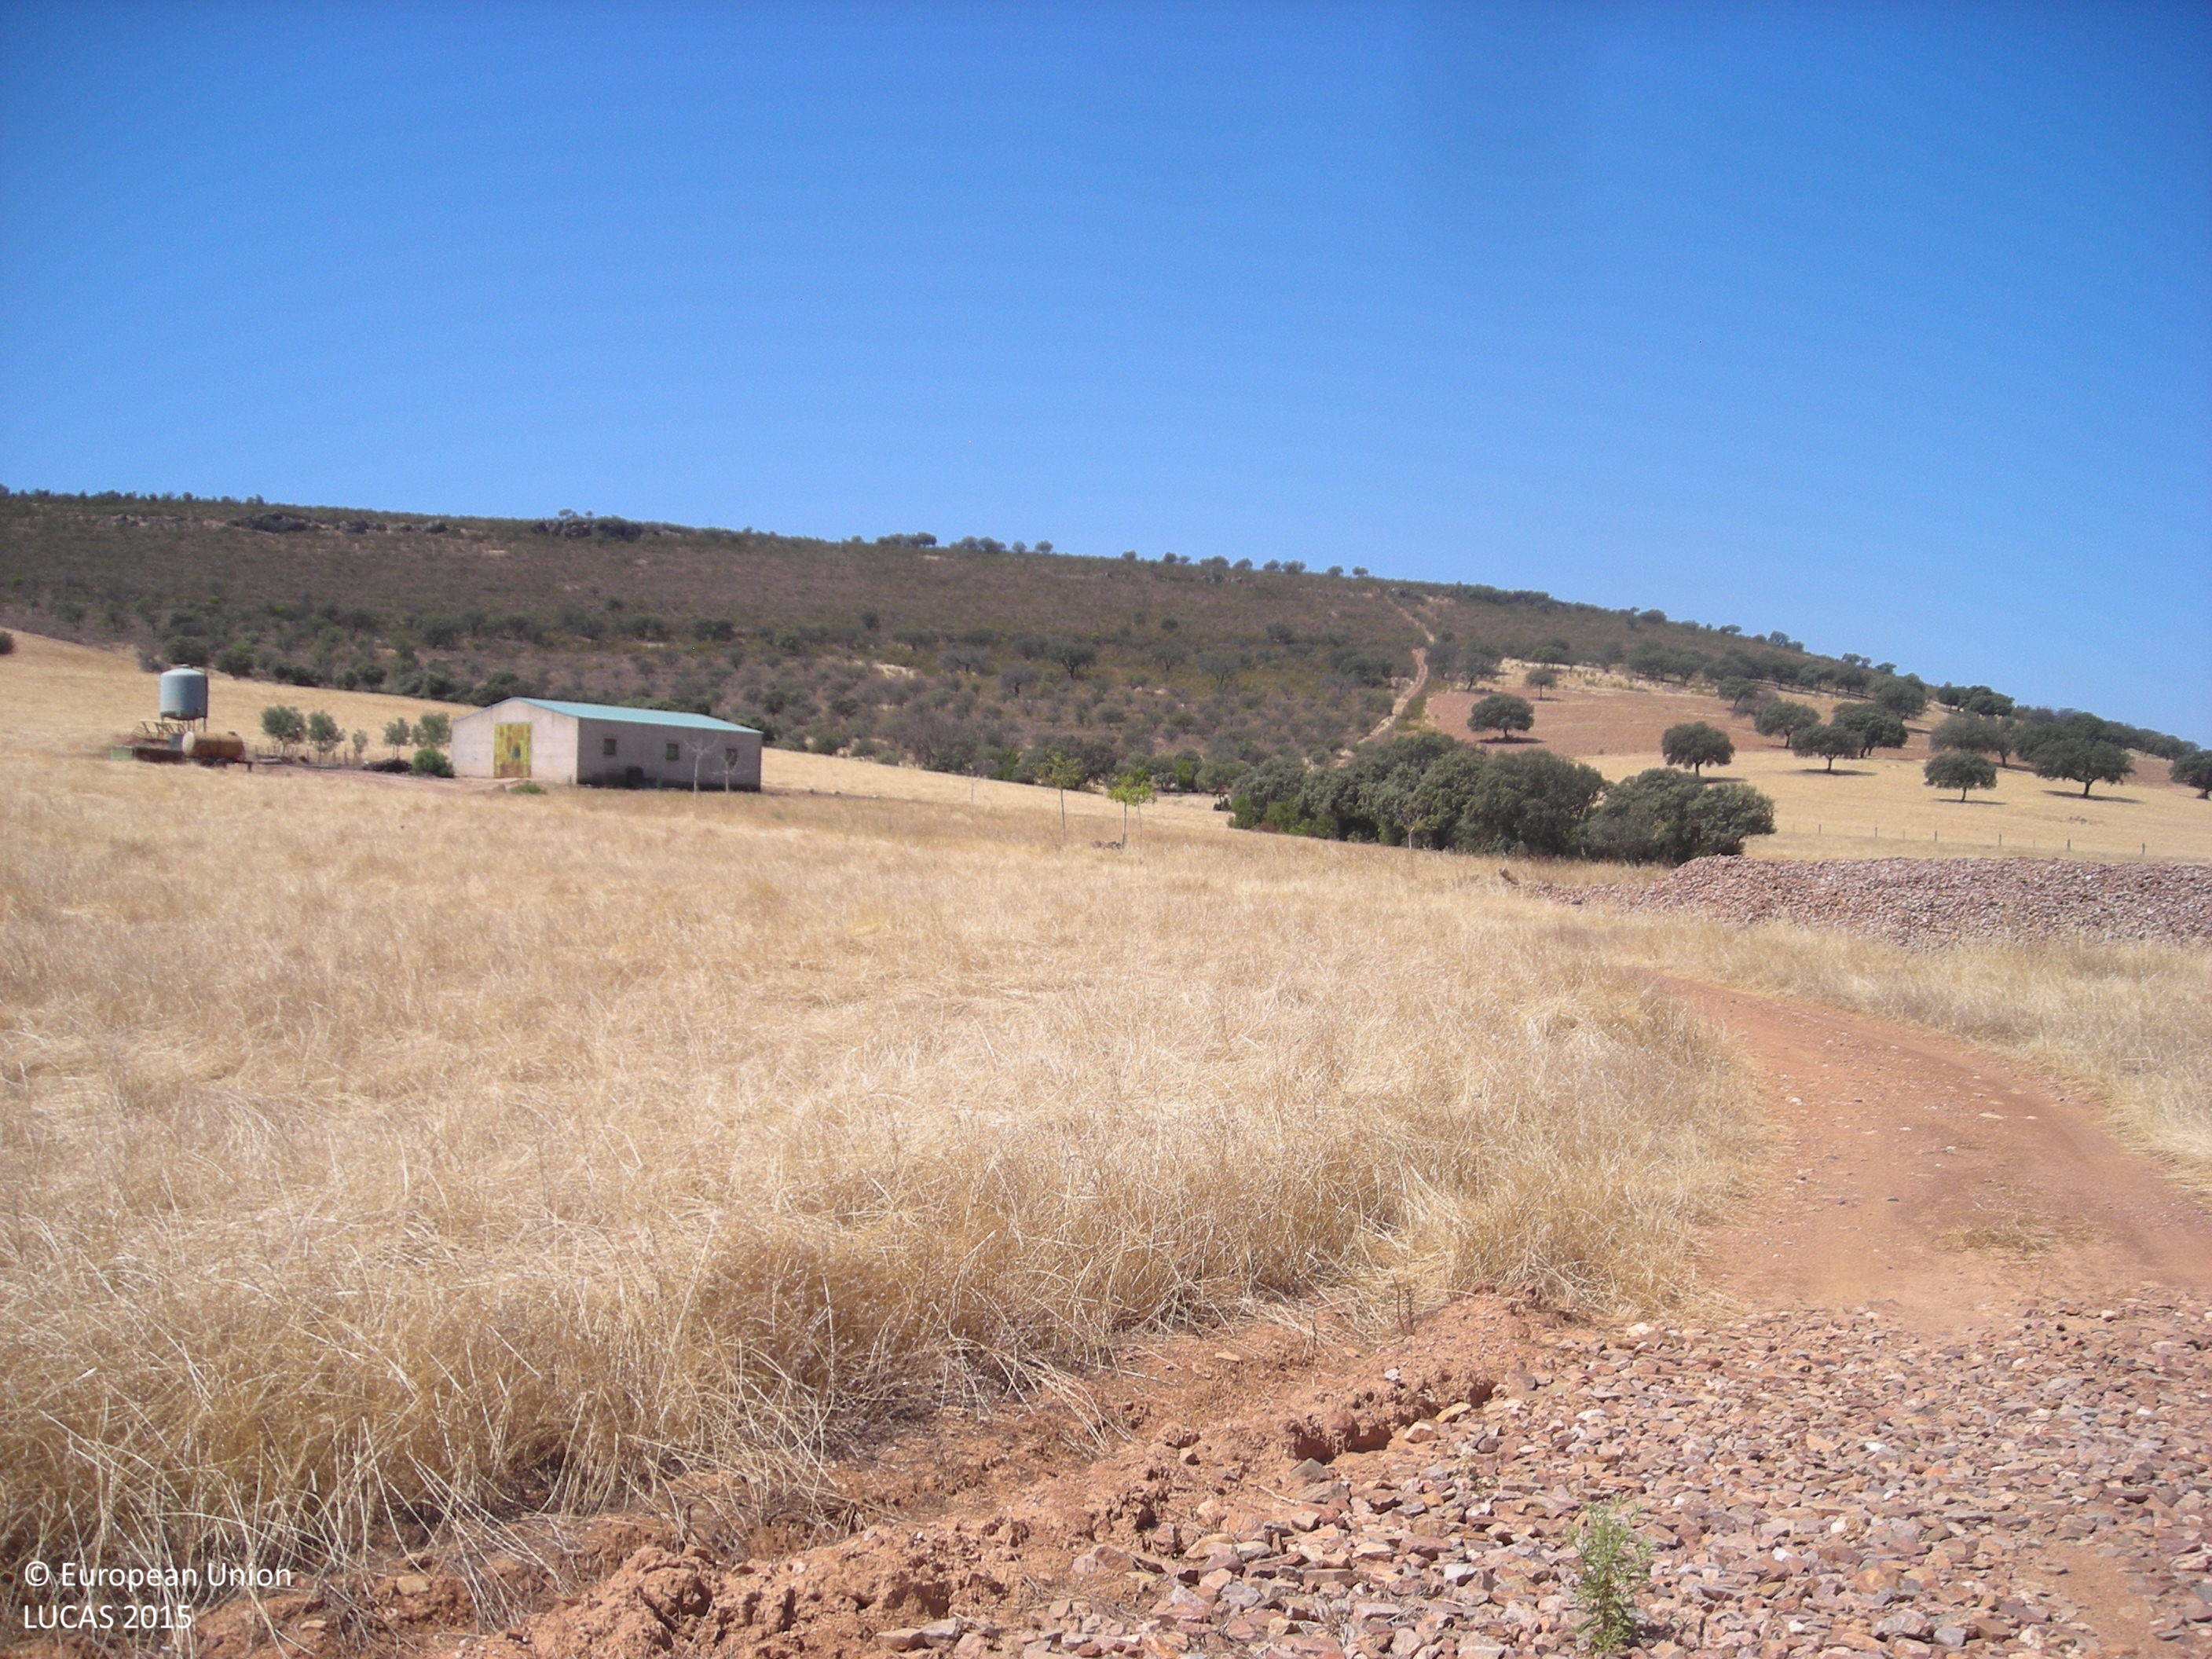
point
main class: Woodland
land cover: Broadleaved woodland
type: broadleaved evergreen forest
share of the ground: 25 - 50 %
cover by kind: broadleaved forest trees 40 %, shrubs 30 %, herbaceous plants 30 %
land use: Forestry
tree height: > 5 m
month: July
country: ES
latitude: 38.7638
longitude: -5.8704
